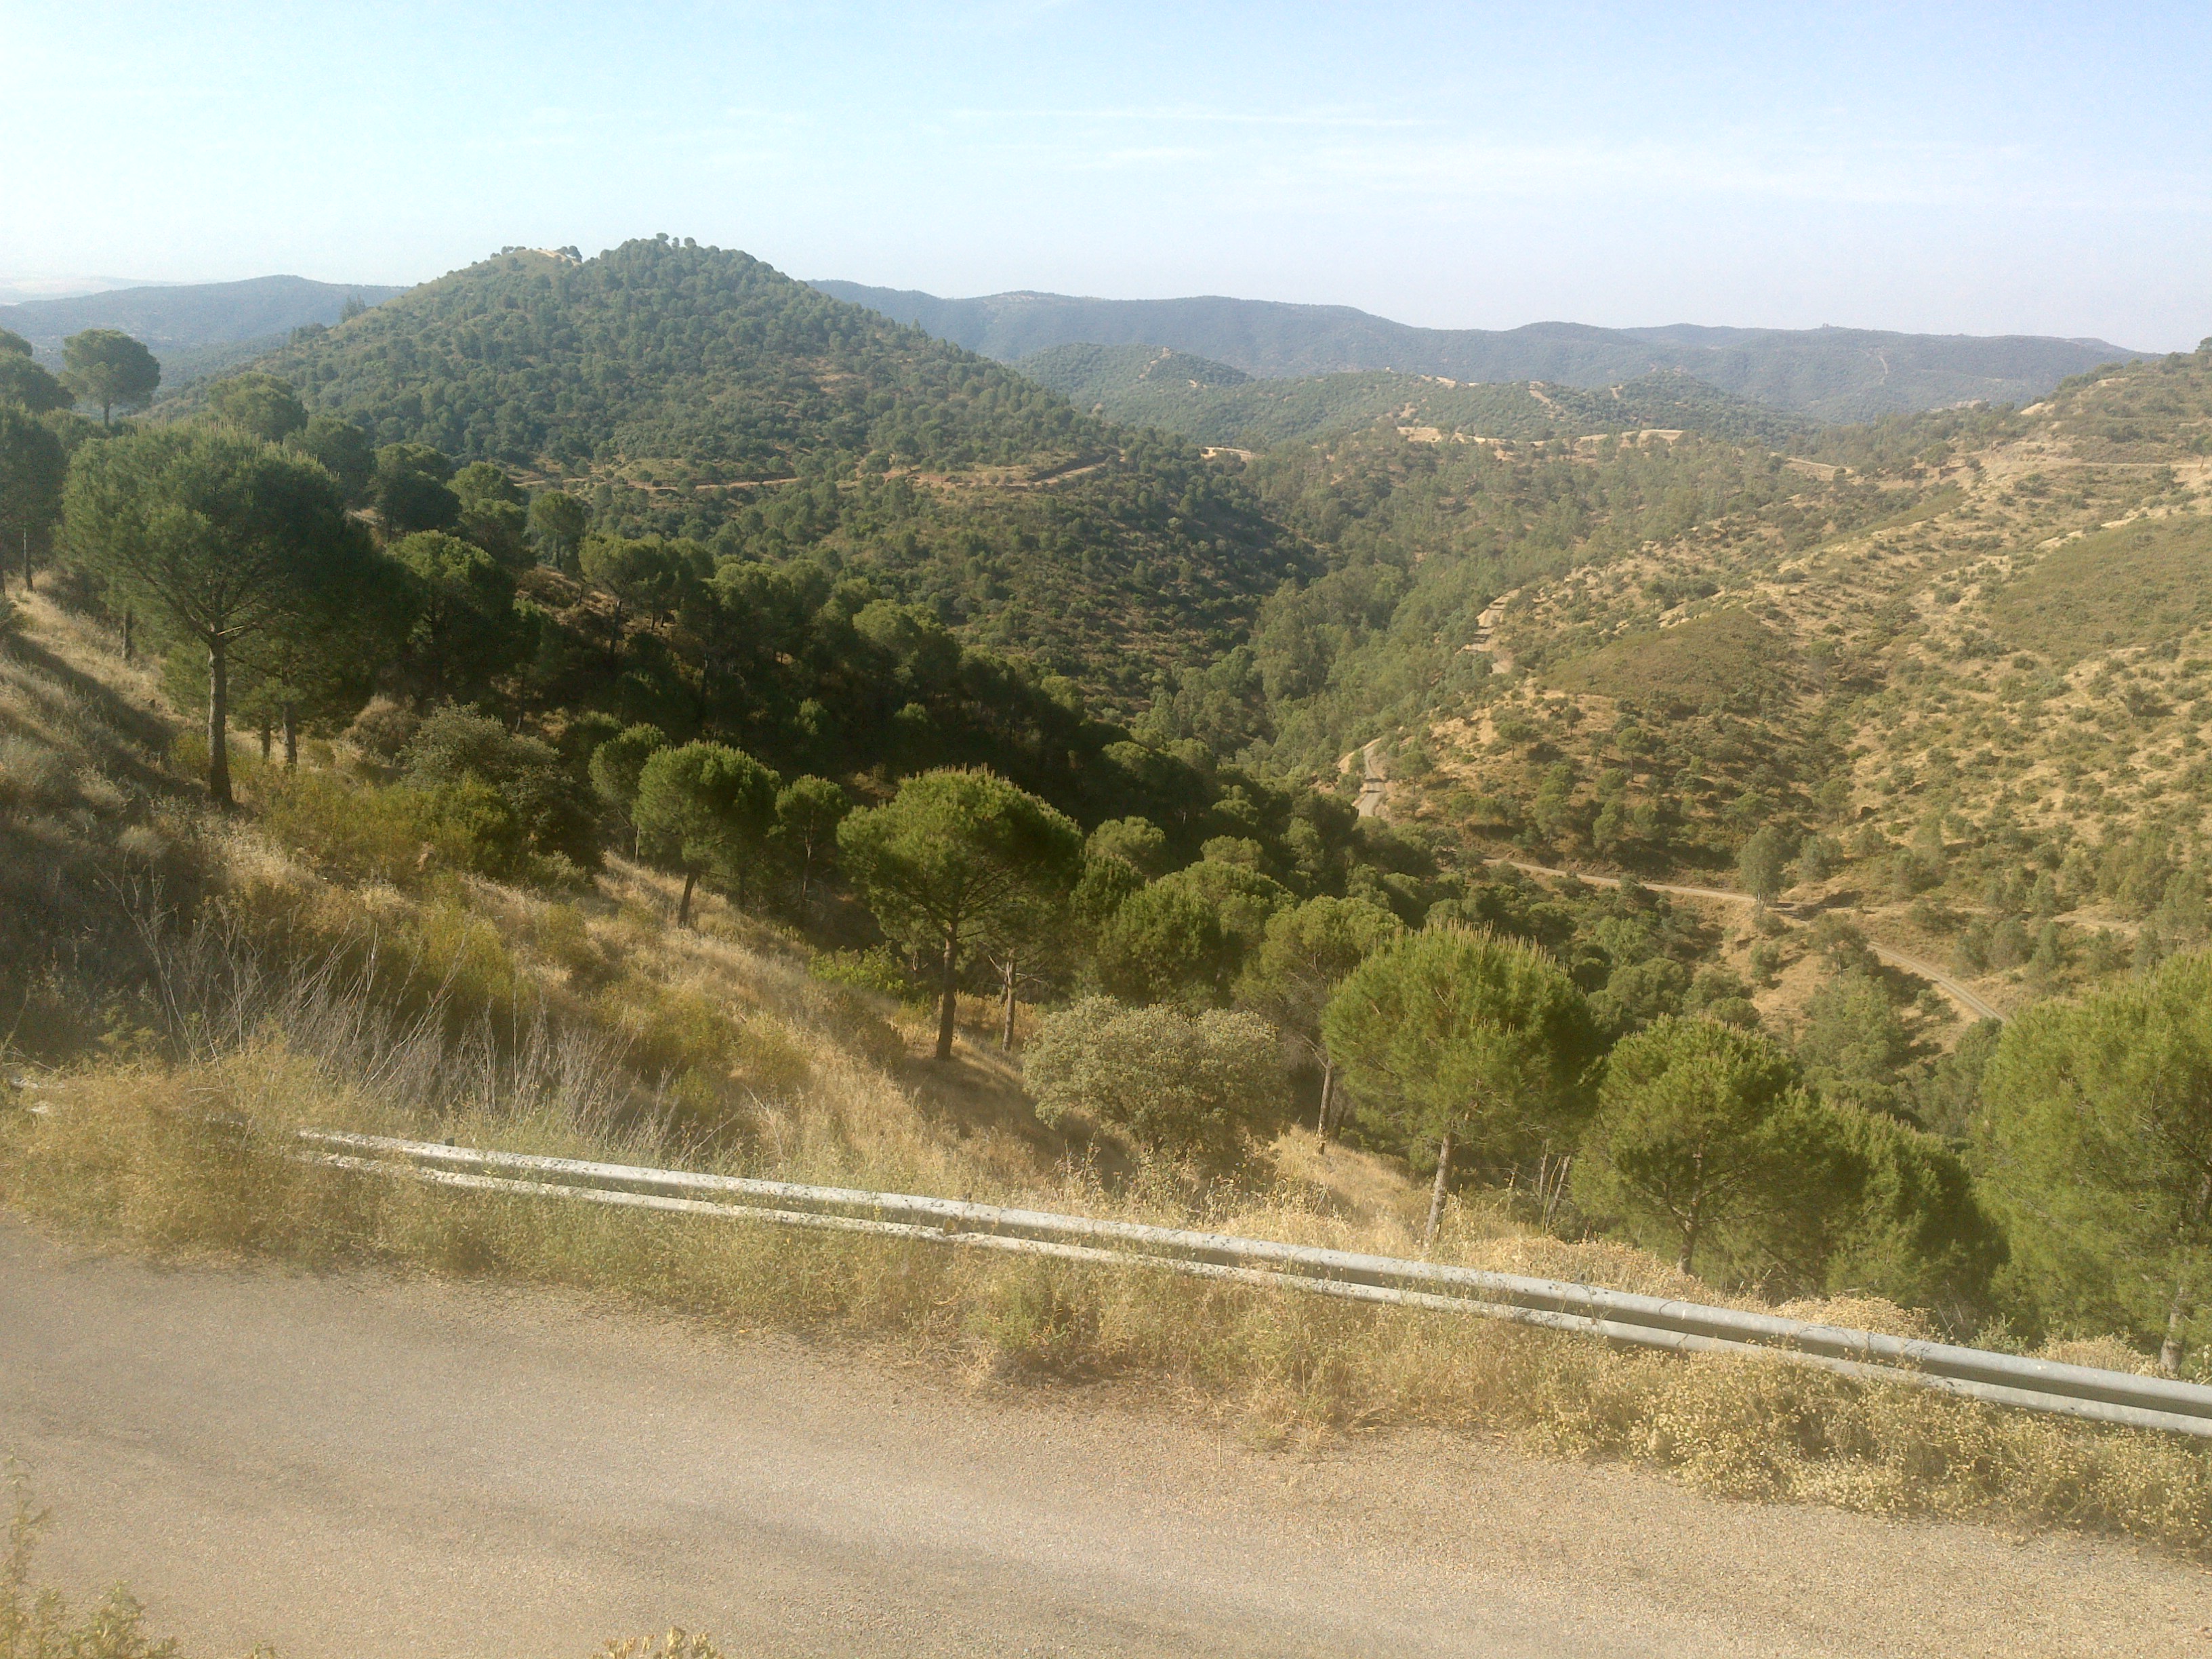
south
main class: Woodland
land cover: Pine dominated coniferous woodland
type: coniferous forest of the mediterranean region
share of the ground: 10 - 25 %
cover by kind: herbaceous plants 60 %, coniferous forest trees 20 %, shrubs 15 %, broadleaved forest trees 5 %
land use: Forestry
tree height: > 5 m
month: May
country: ES
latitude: 38.0361
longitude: -4.6790
